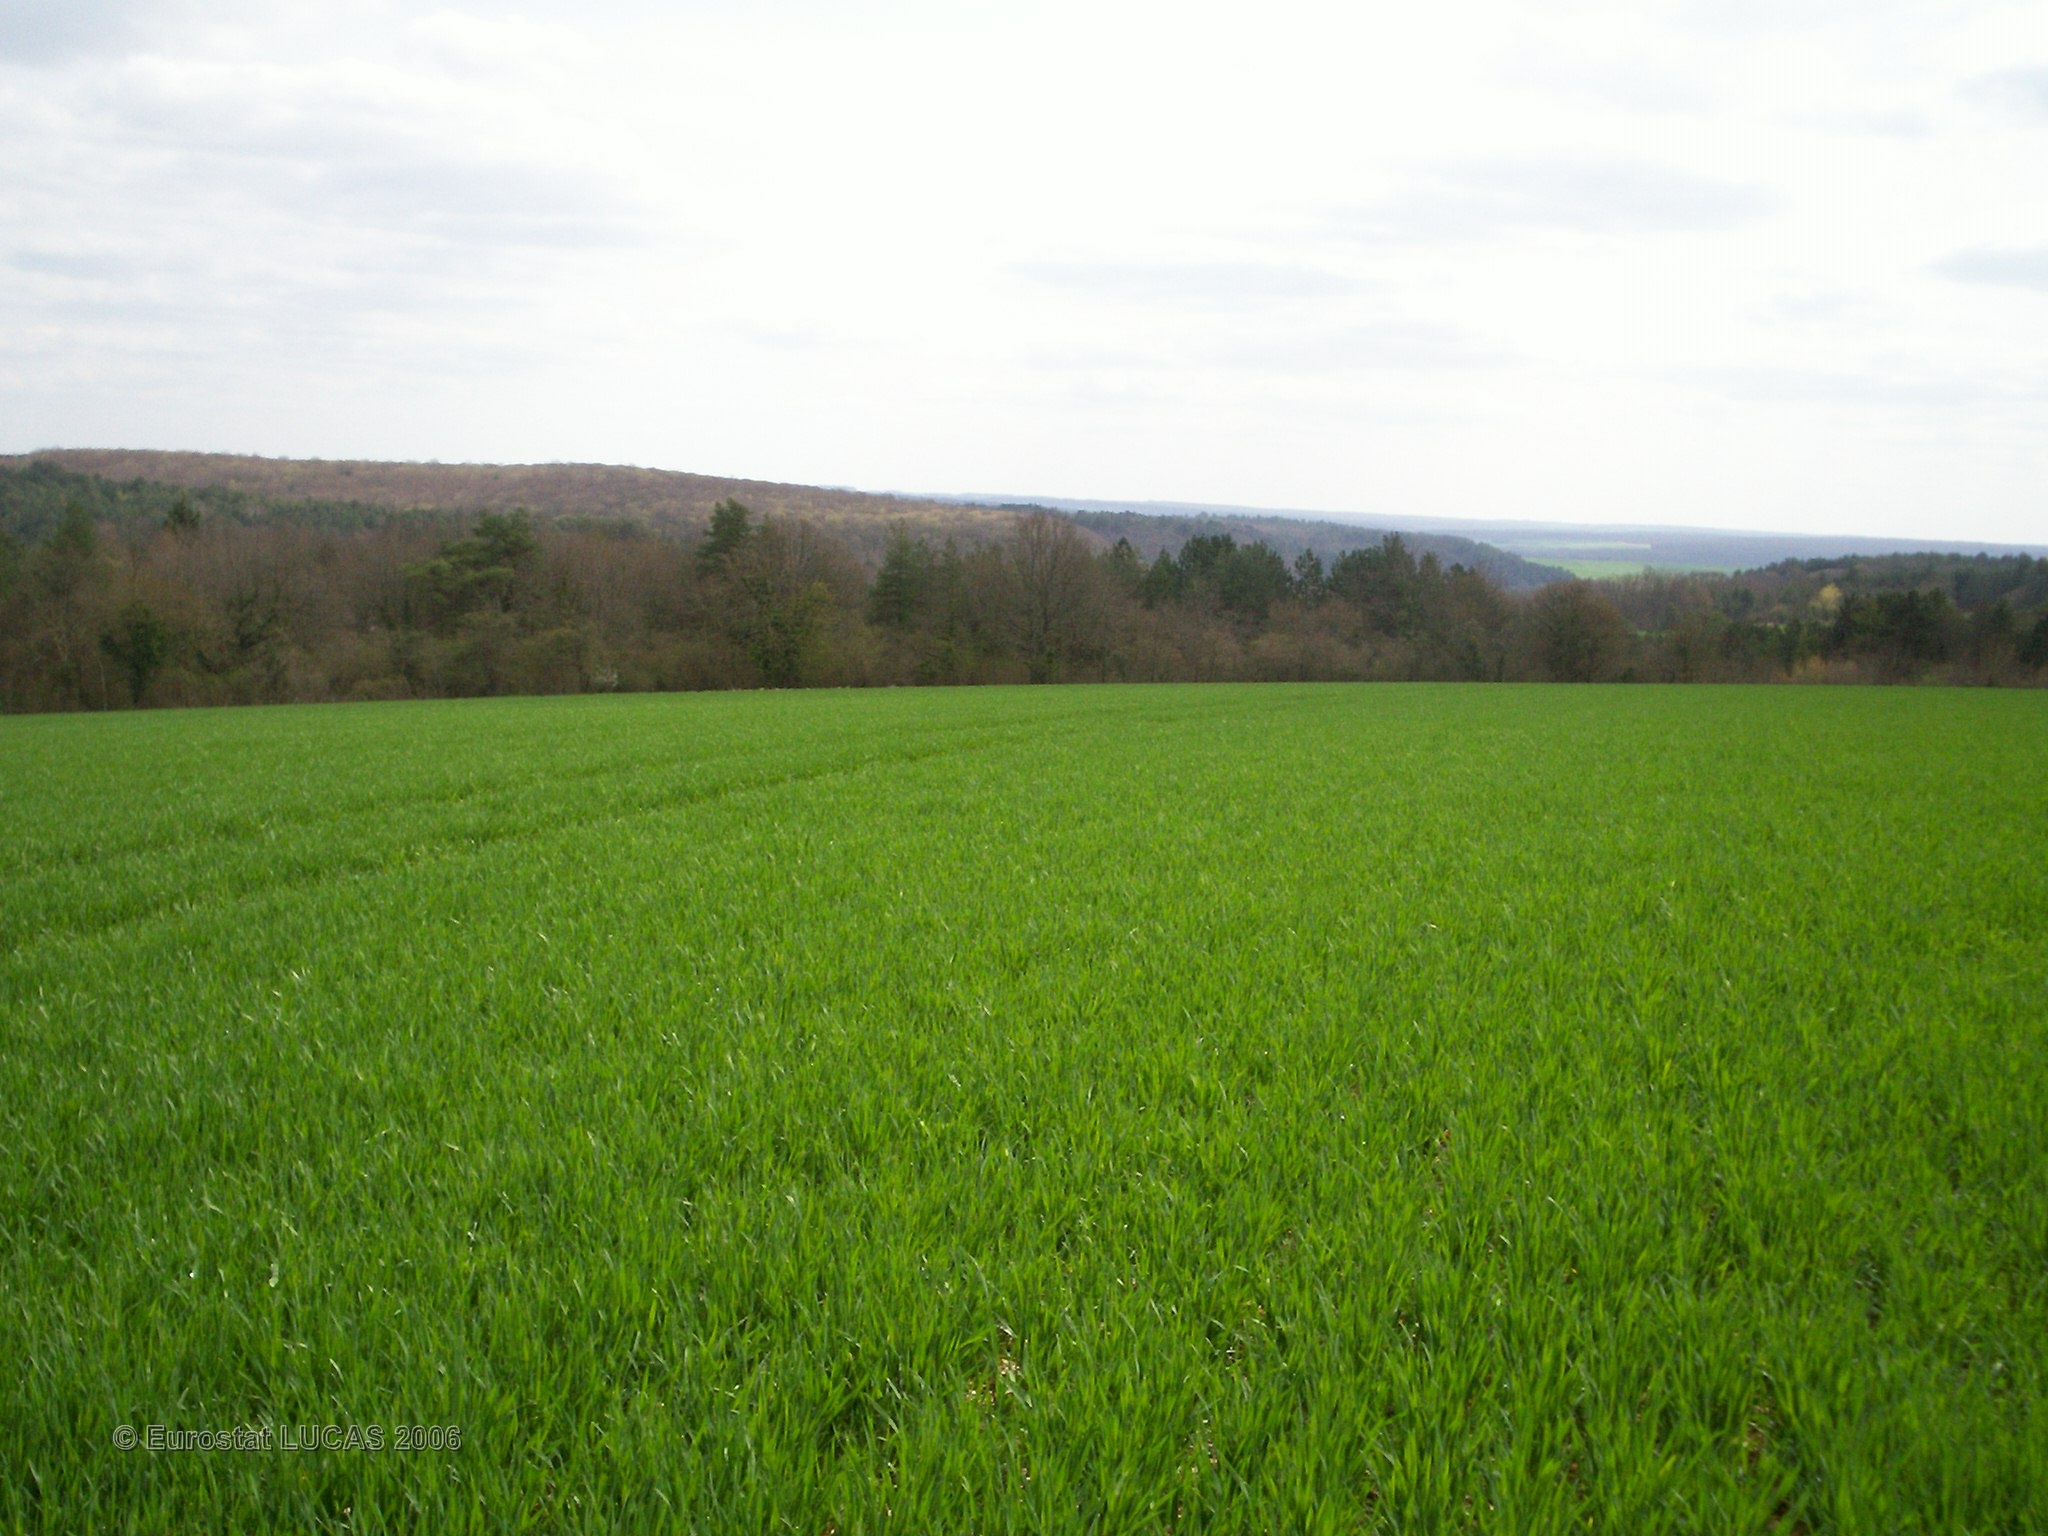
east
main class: Cropland
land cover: Common wheat
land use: Agriculture (excluding fallow land and kitchen gardens)
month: April
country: FR
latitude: 47.8822
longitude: 4.0464
